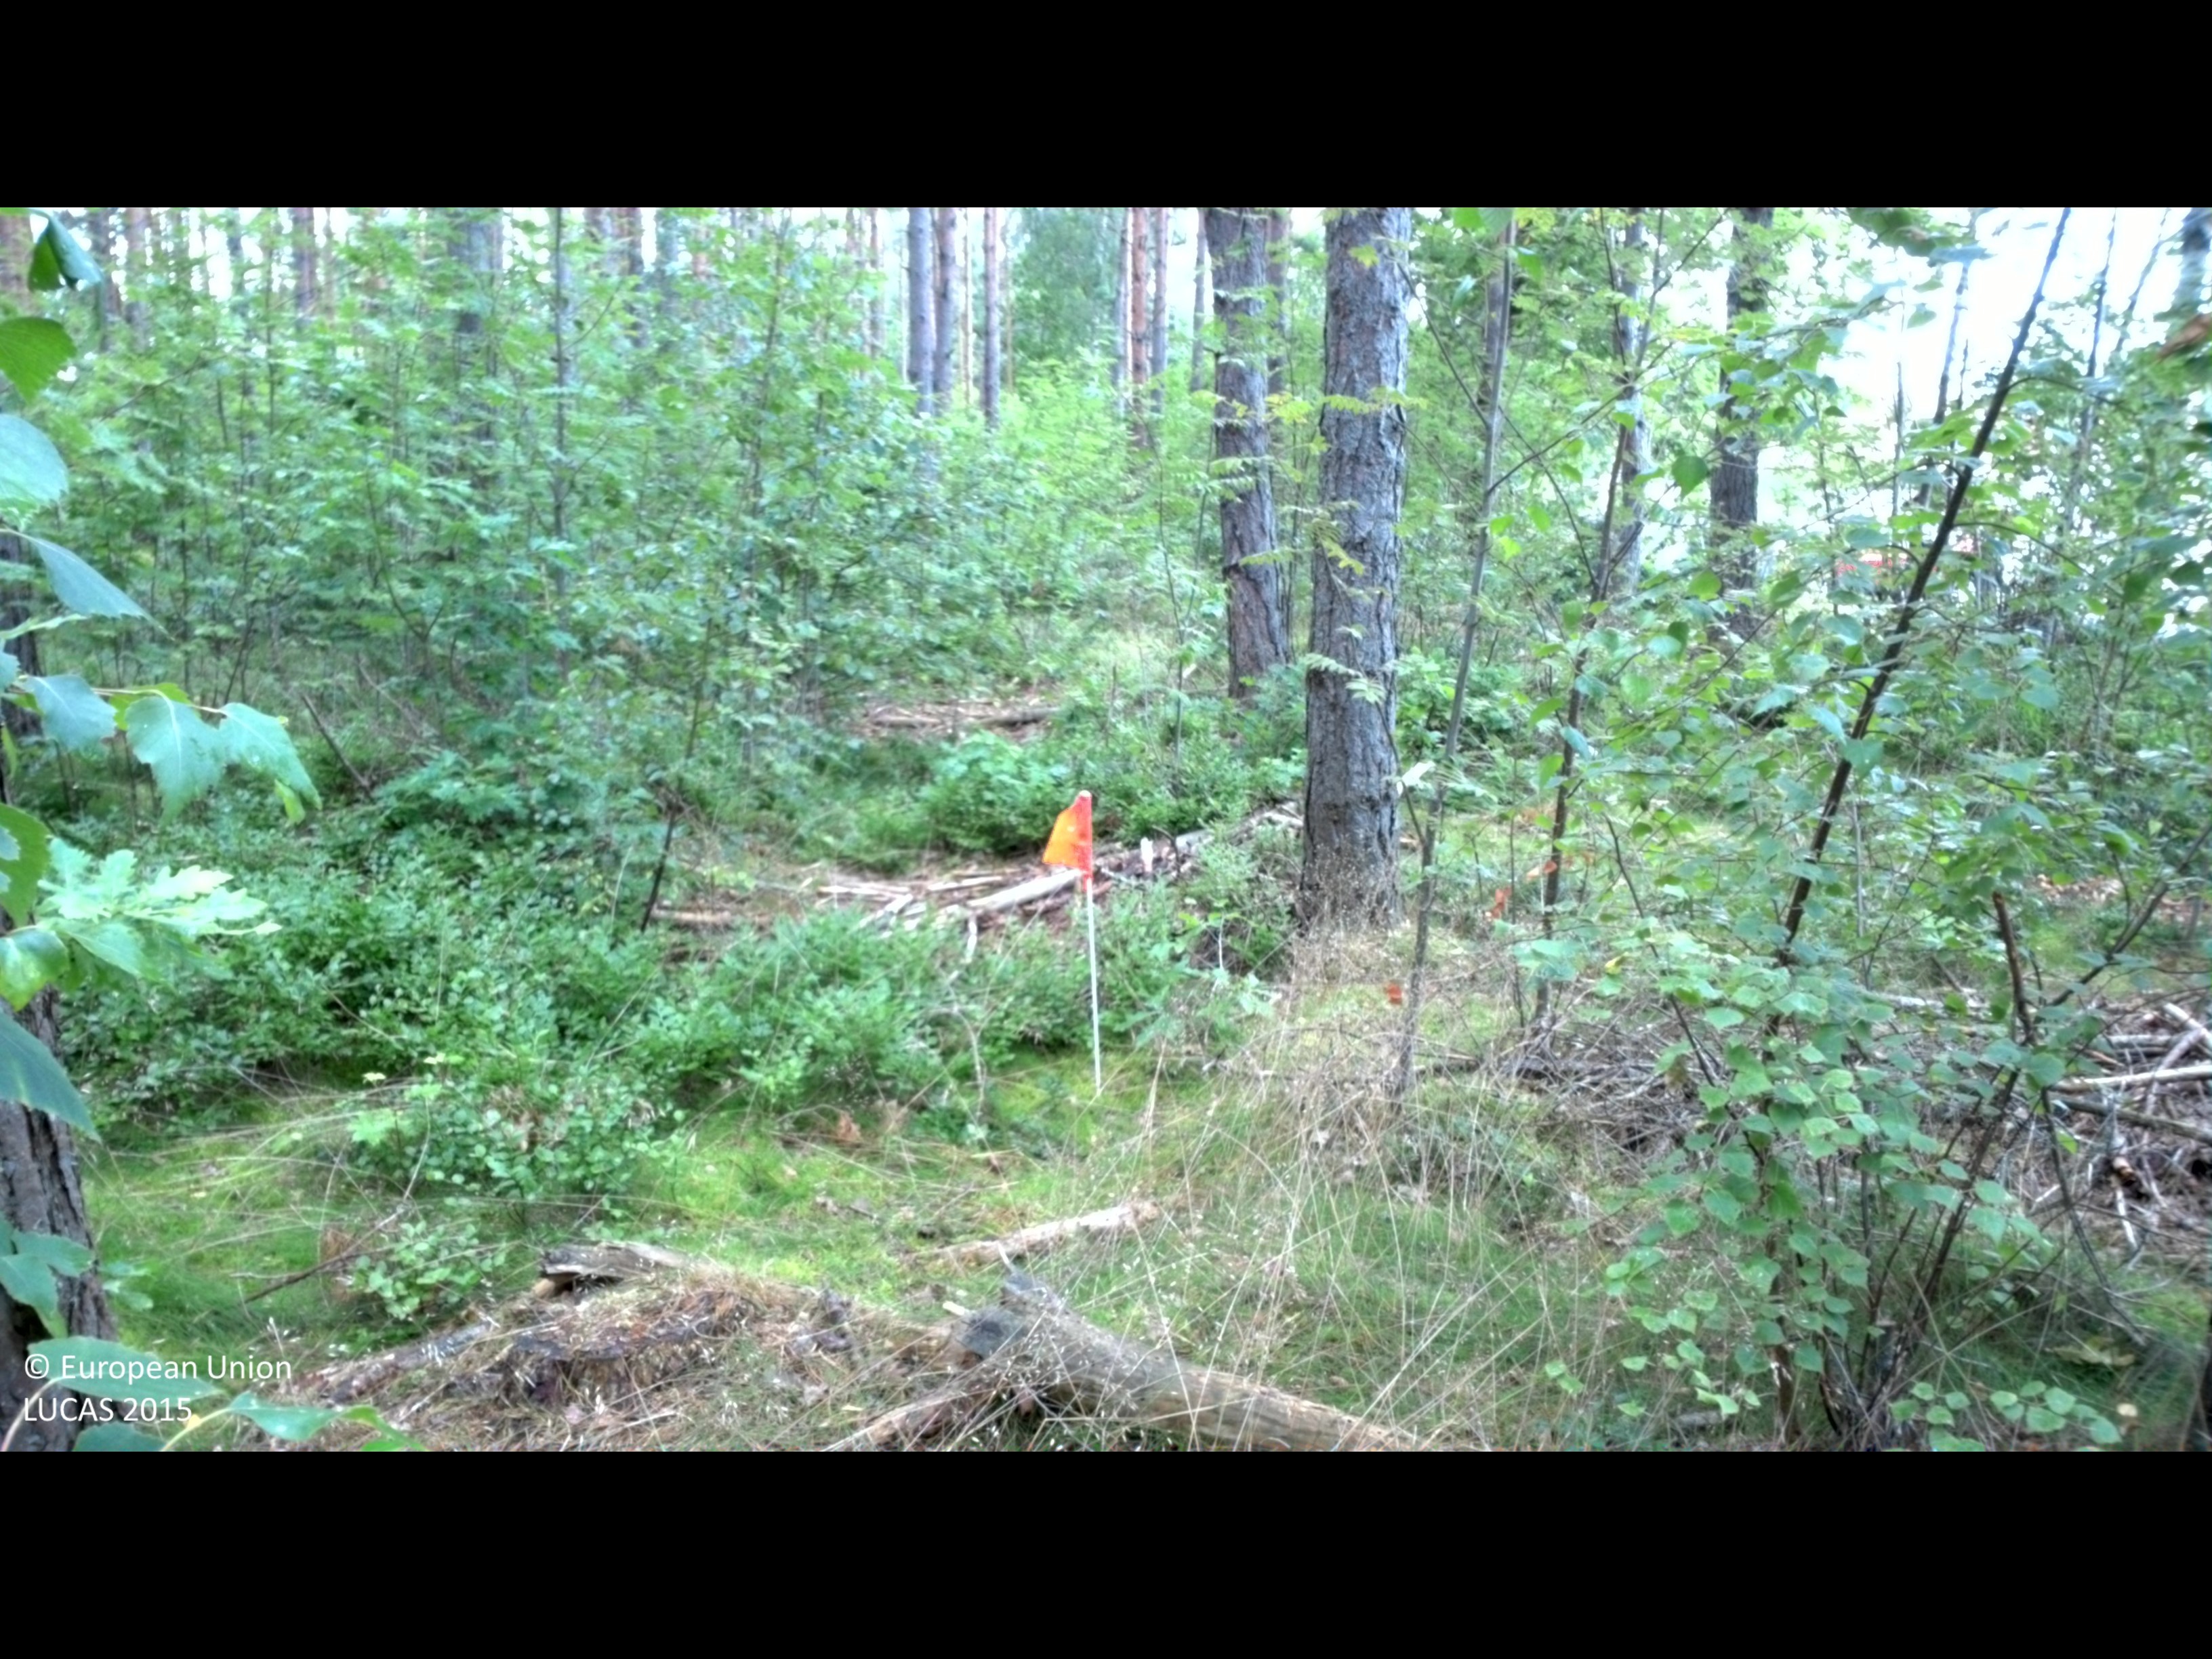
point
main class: Woodland
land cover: Pine dominated coniferous woodland
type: boreal forest
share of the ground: 50 - 75 %
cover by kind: coniferous forest trees 65 %, shrubs 20 %, broadleaved forest trees 10 %, herbaceous plants 5 %
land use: Forestry
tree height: > 5 m
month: July
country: SE
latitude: 57.2579
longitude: 17.0473
